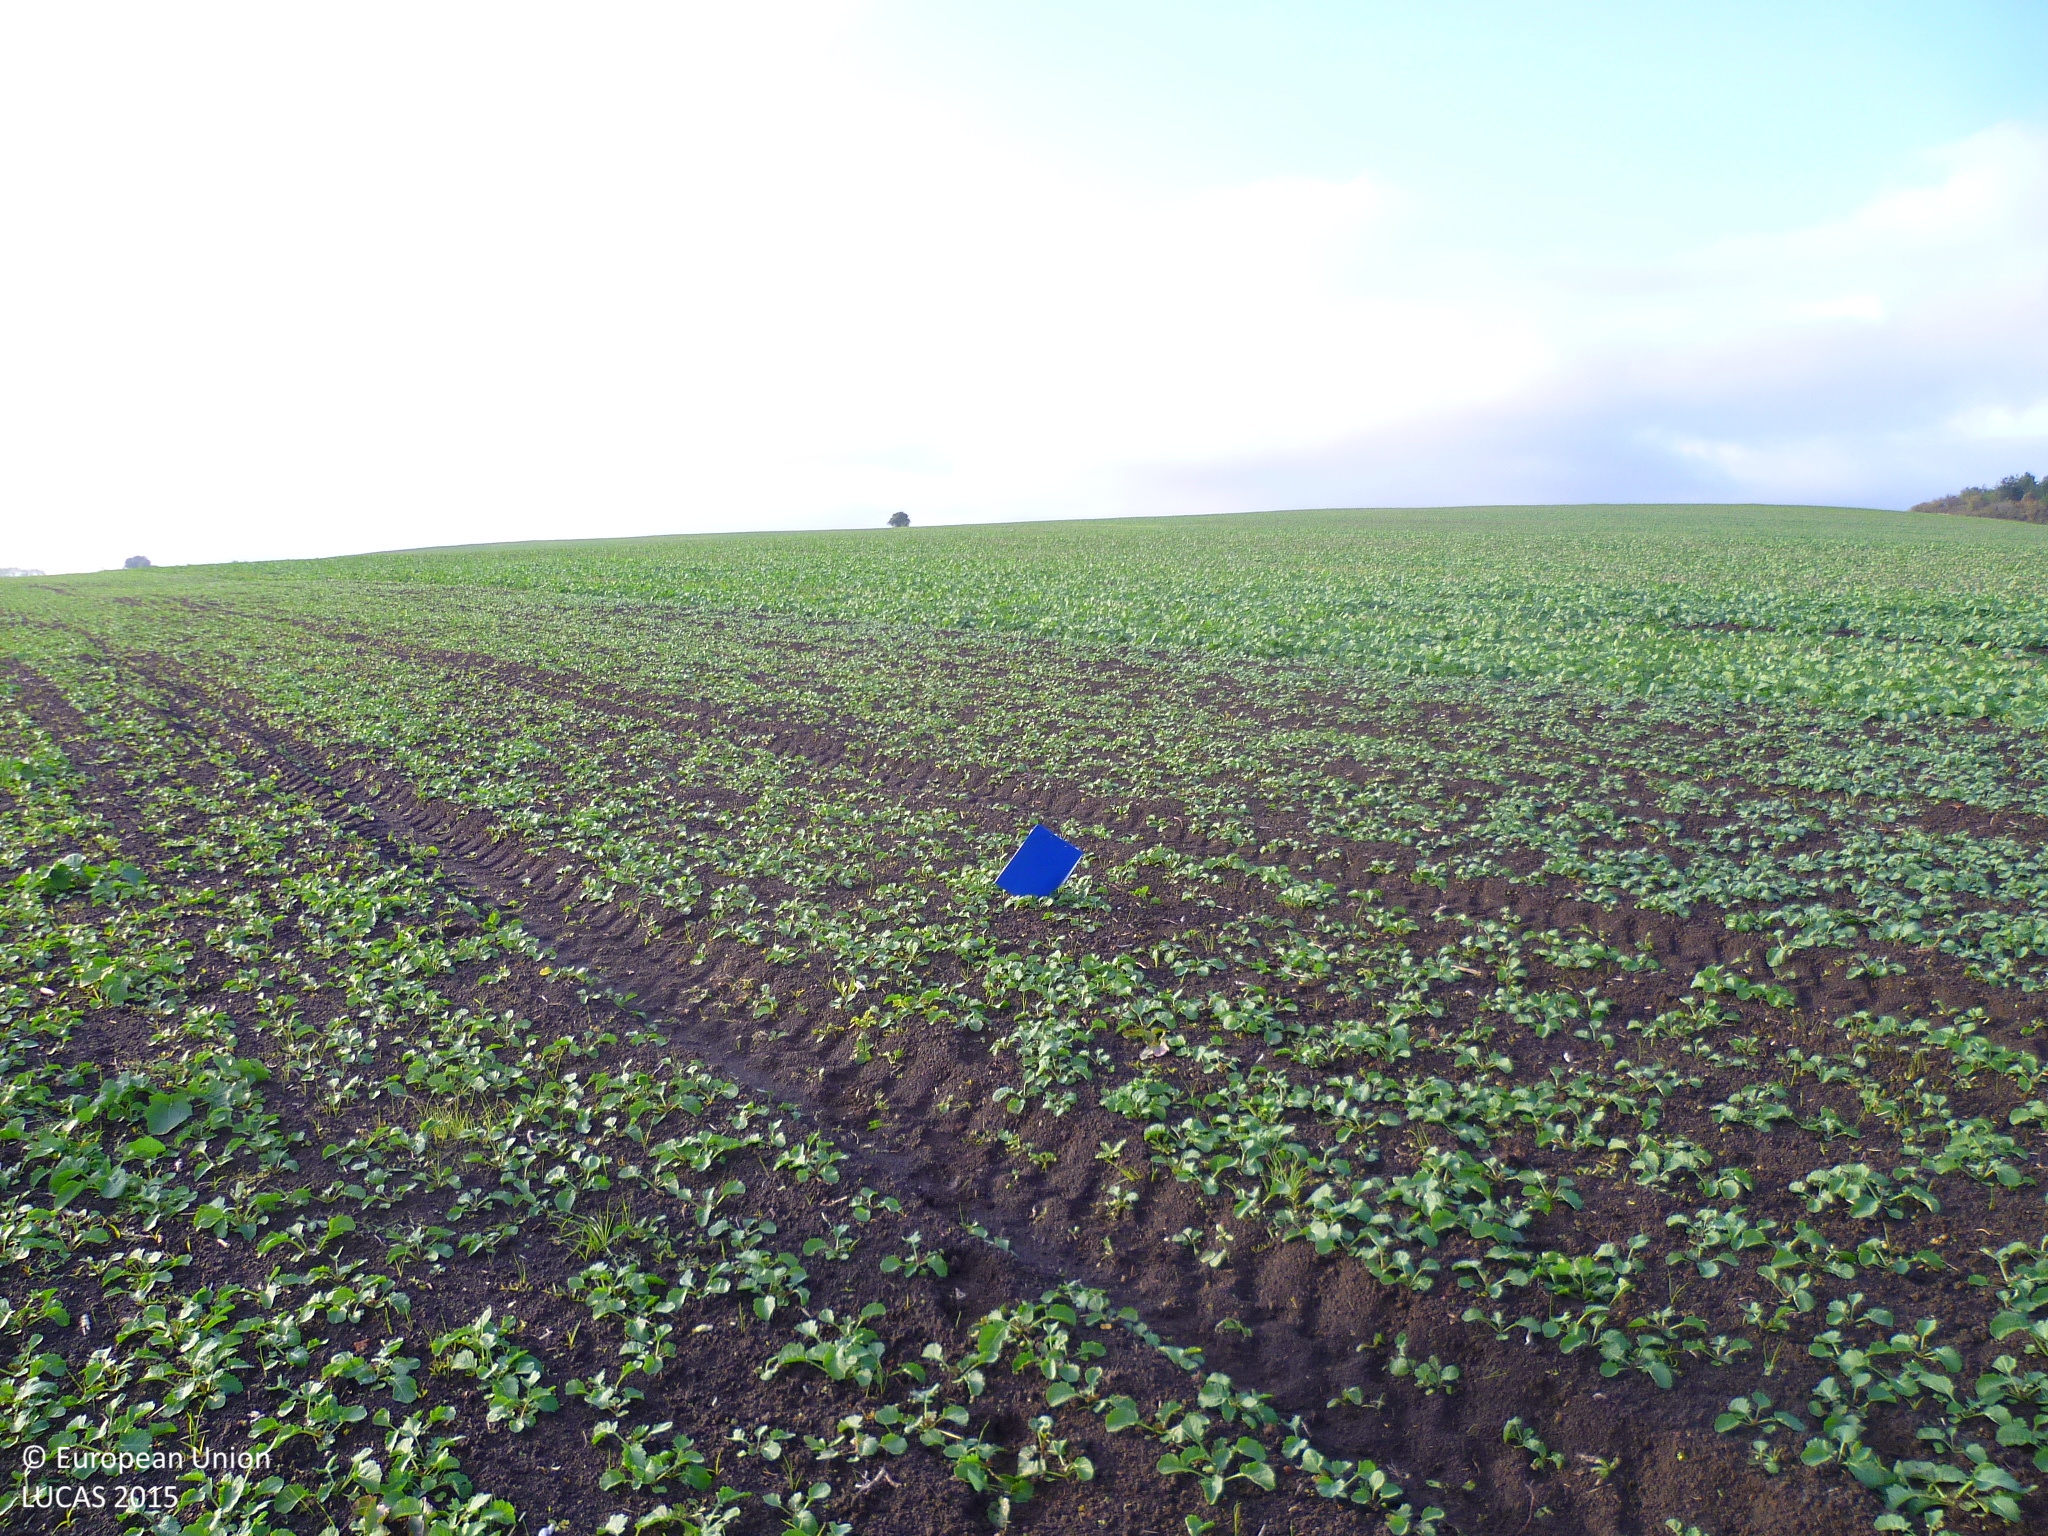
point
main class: Cropland
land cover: Rape and turnip rape
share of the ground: 50 - 75 %
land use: Agriculture (excluding fallow land and kitchen gardens)
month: October
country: BG
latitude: 42.7596
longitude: 23.0196
